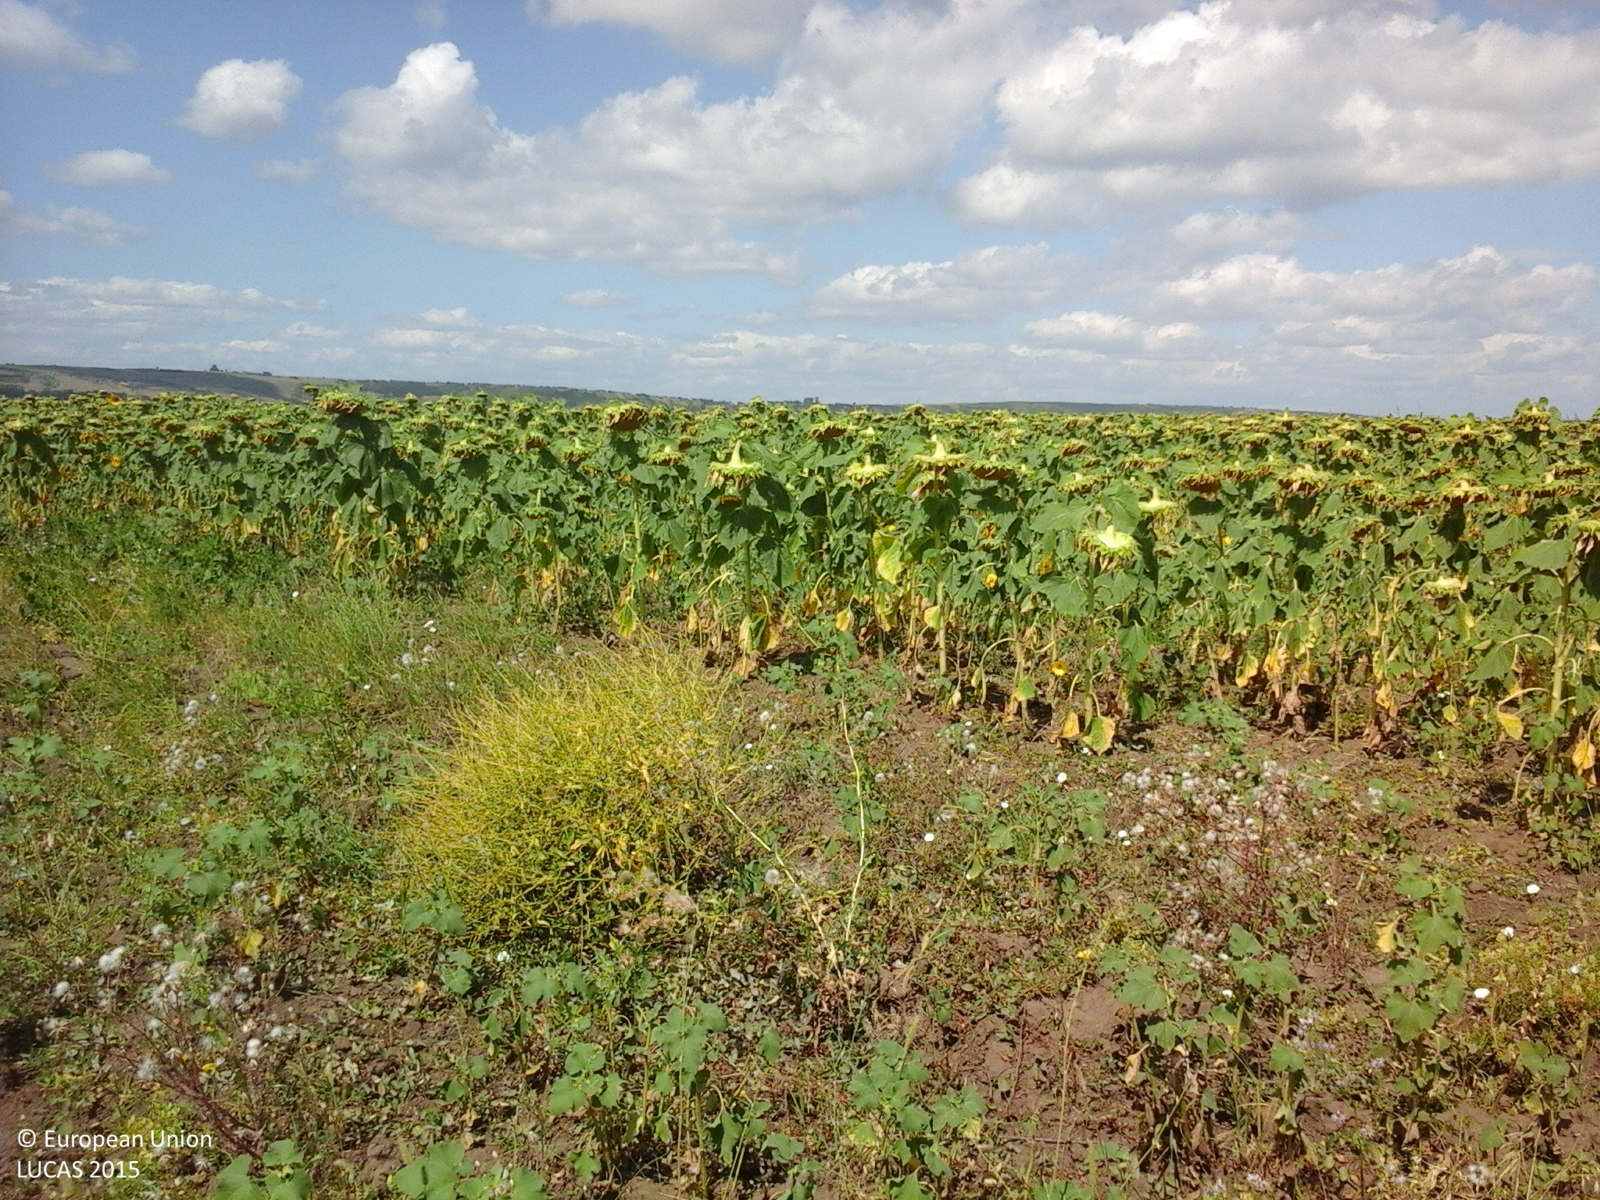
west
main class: Grassland
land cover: Spontaneously vegetated surfaces
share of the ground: > 75 %
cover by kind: herbaceous plants 100 %
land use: Fallow land
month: July
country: RO
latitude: 46.3312
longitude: 27.9323
